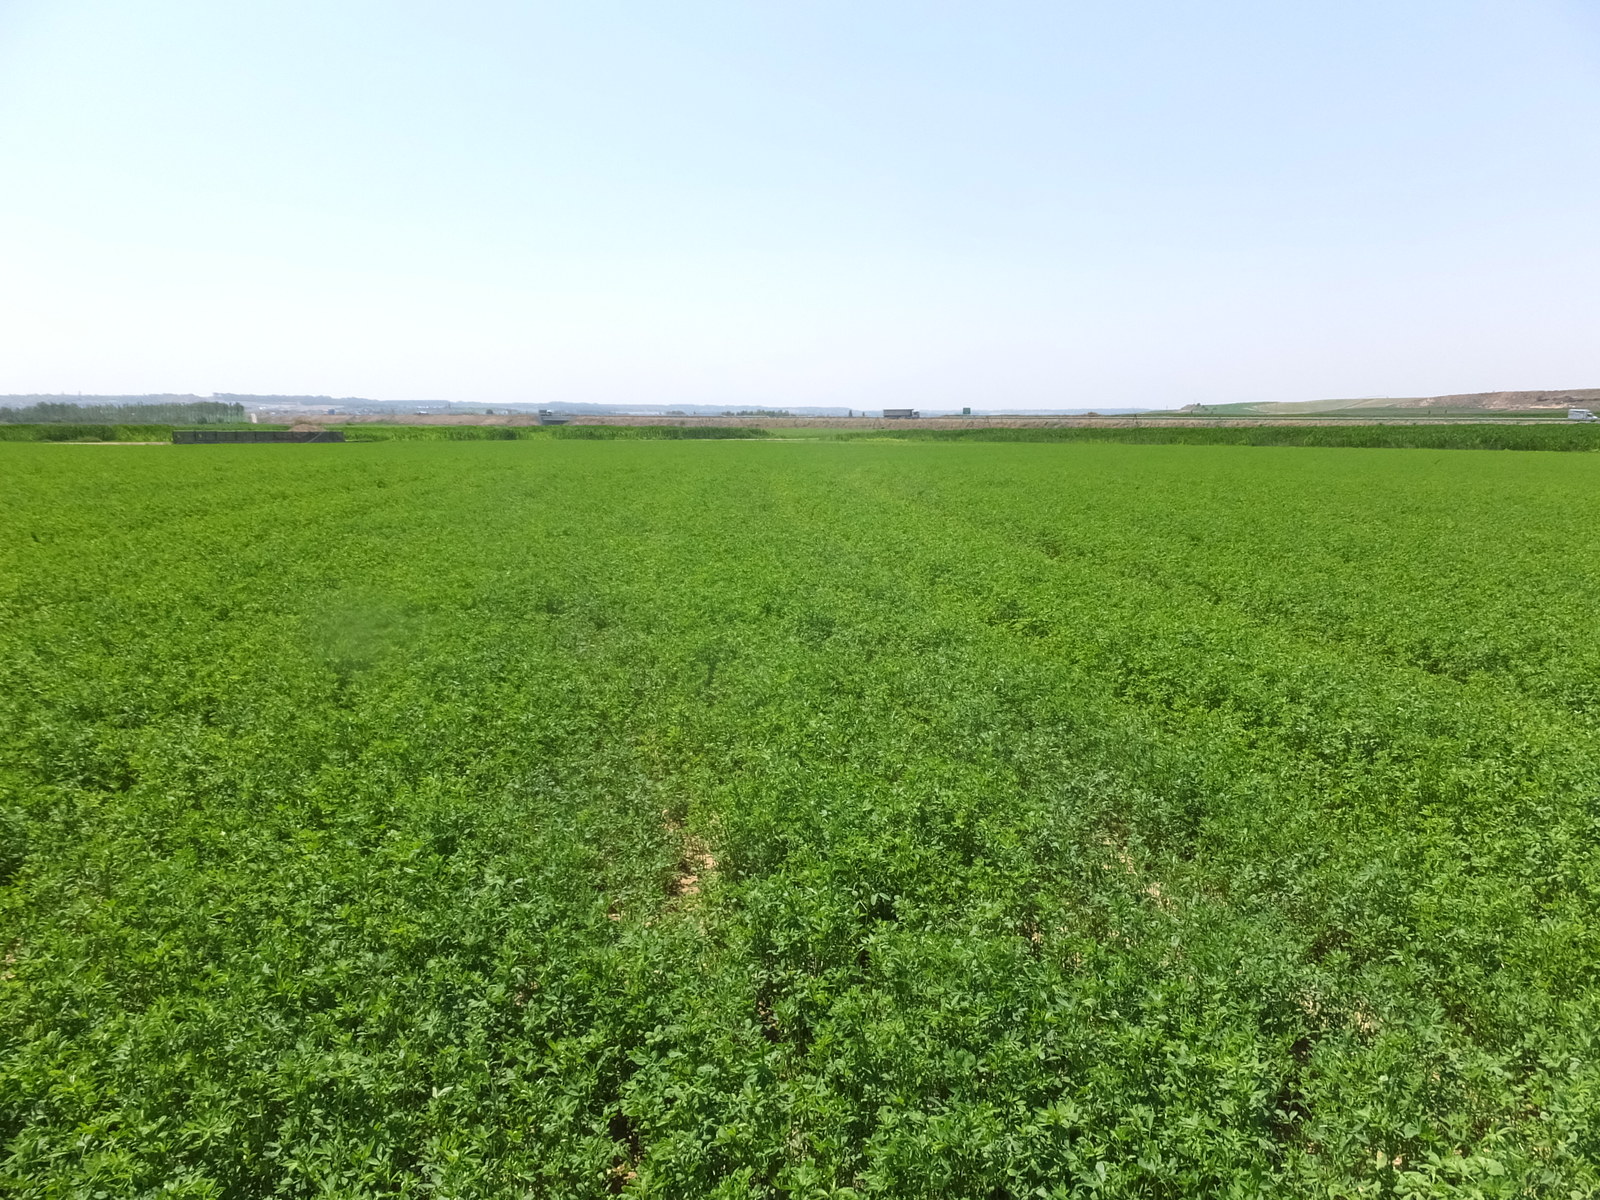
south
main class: Cropland
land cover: Lucerne
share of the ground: > 75 %
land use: Agriculture (excluding fallow land and kitchen gardens)
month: June
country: ES
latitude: 41.7607
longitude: 0.3993
